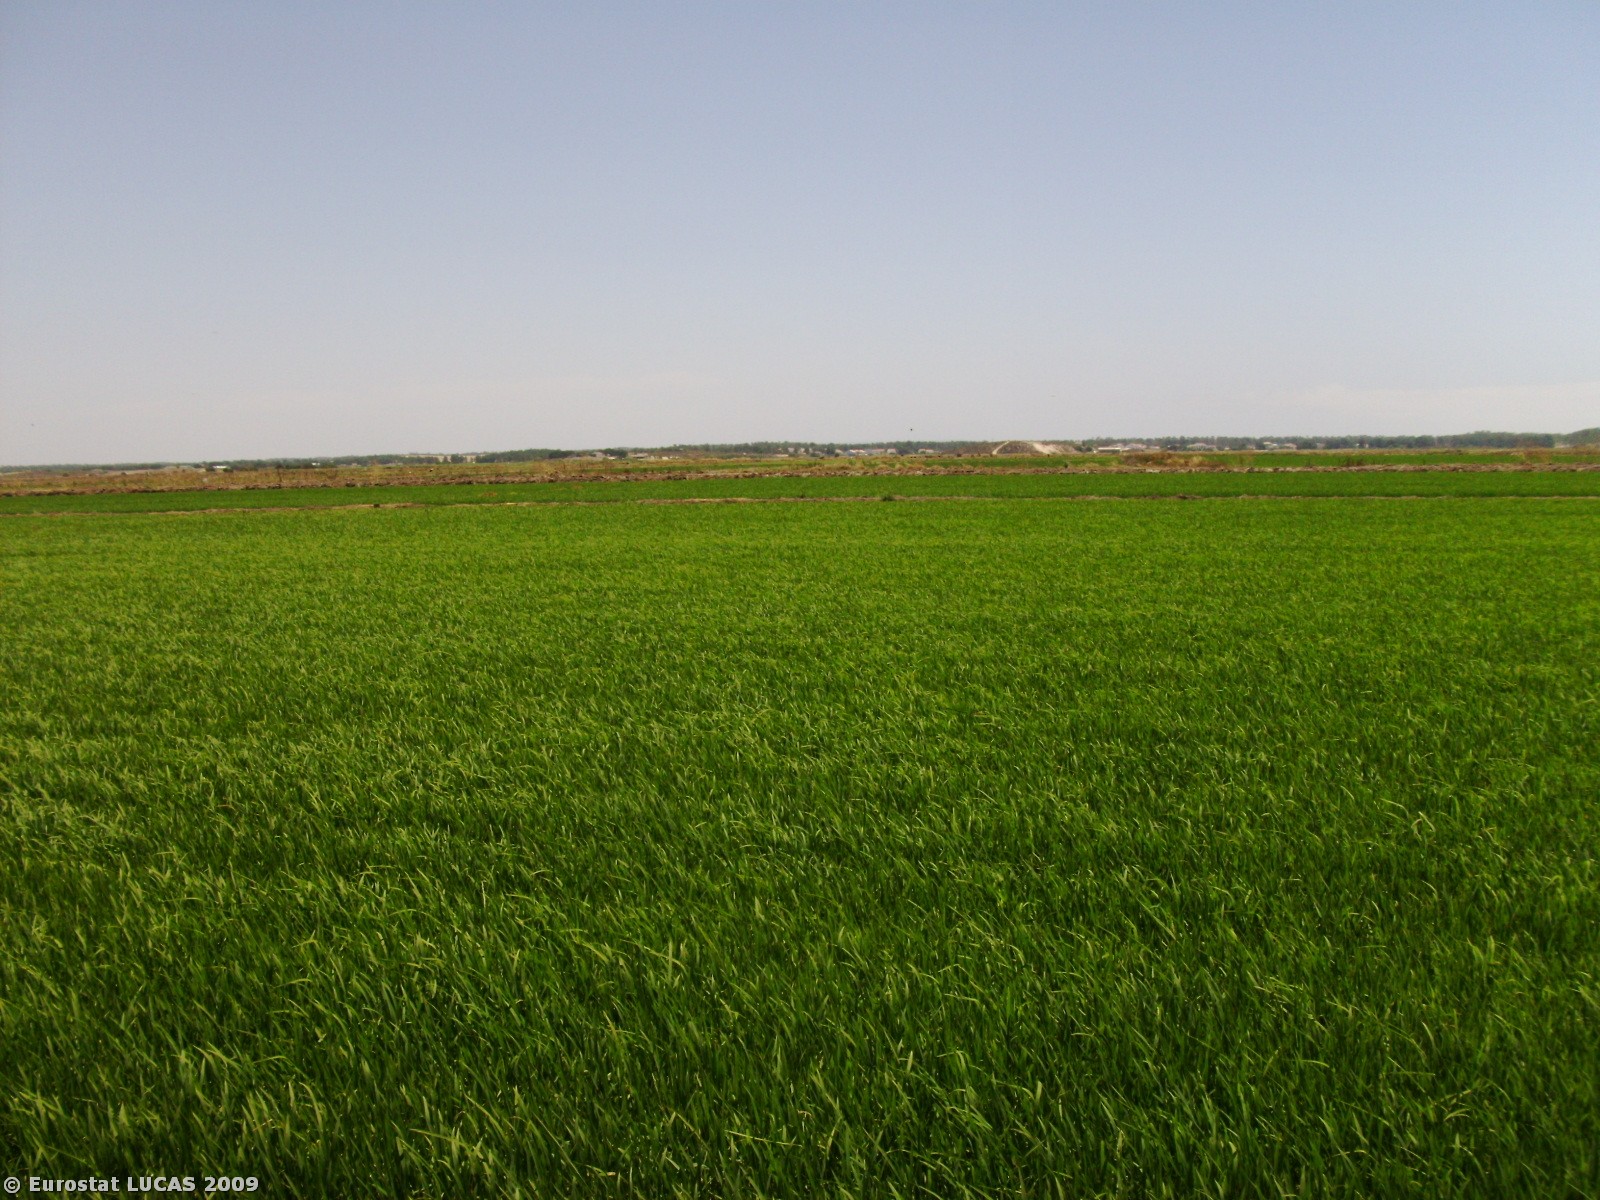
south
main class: Cropland
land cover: Rice
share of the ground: > 75 %
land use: Agriculture (excluding fallow land and kitchen gardens)
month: June
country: PT
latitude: 38.4158
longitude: -8.7847
